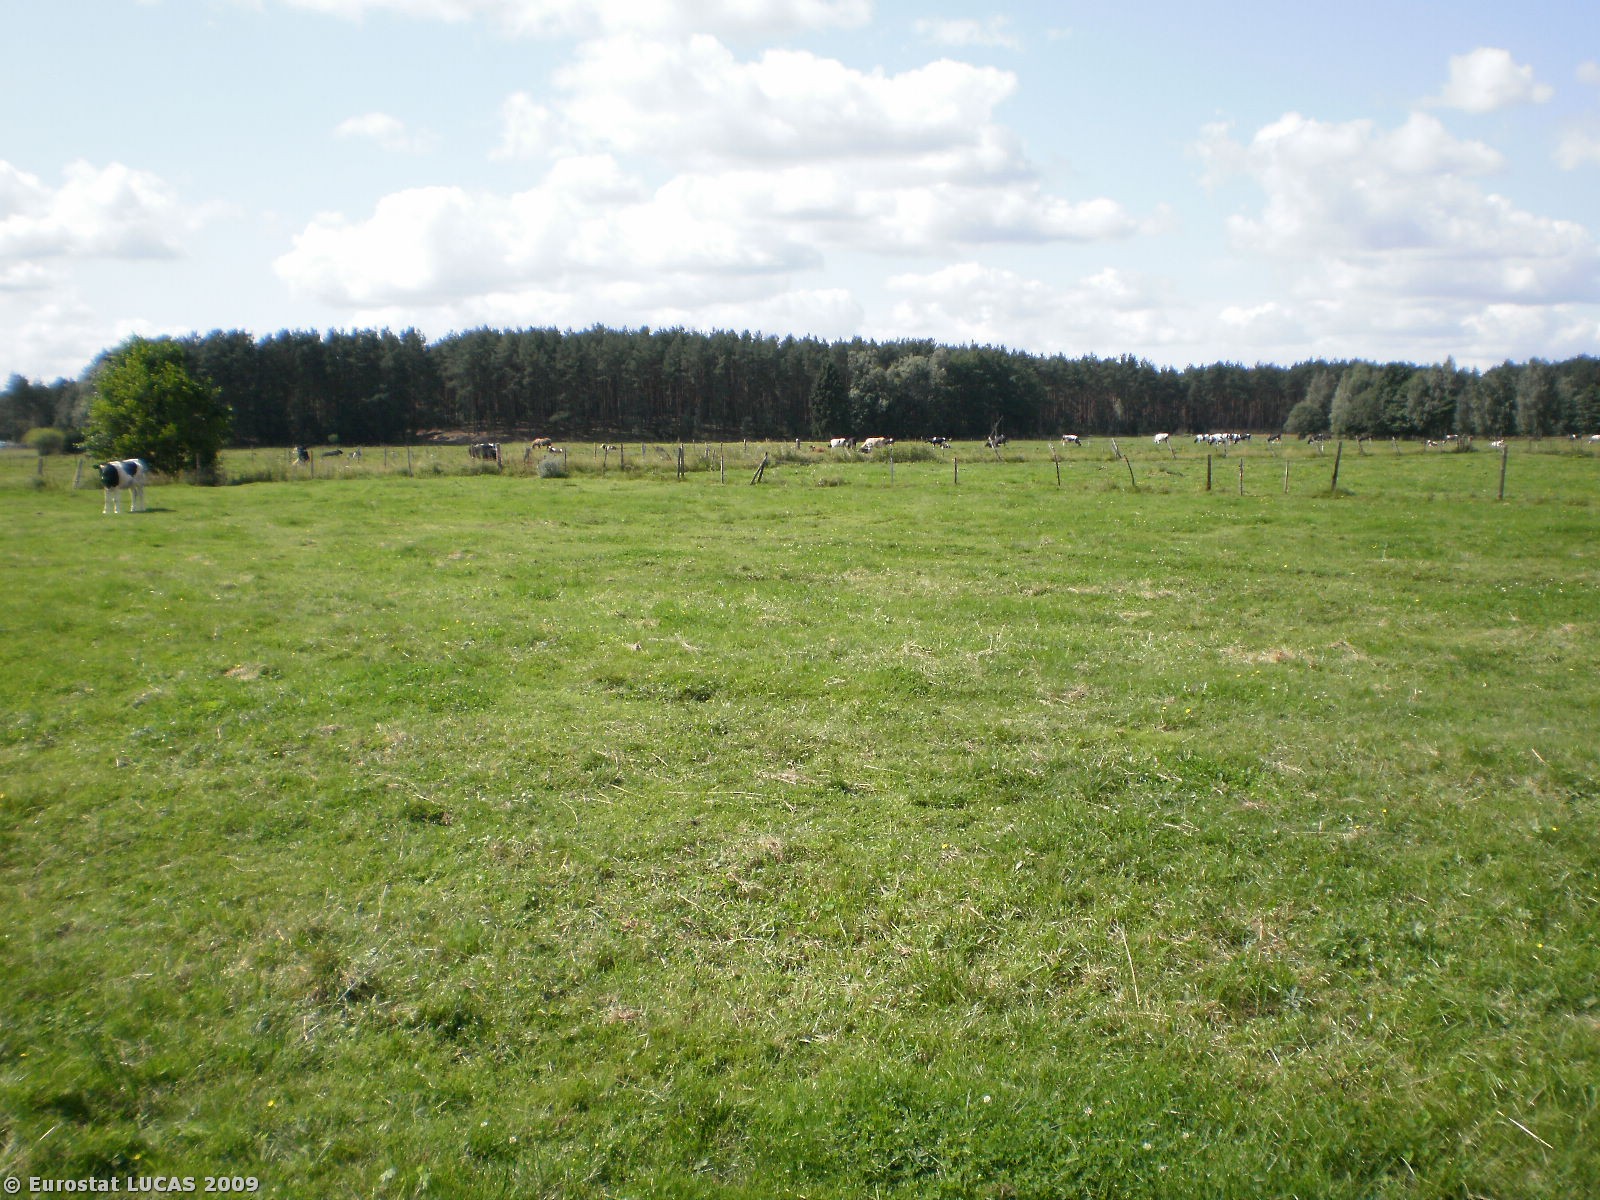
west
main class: Grassland
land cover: Grassland without tree/shrub cover
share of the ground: > 75 %
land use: Agriculture (excluding fallow land and kitchen gardens)
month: August
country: PL
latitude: 53.1309
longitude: 21.2414
